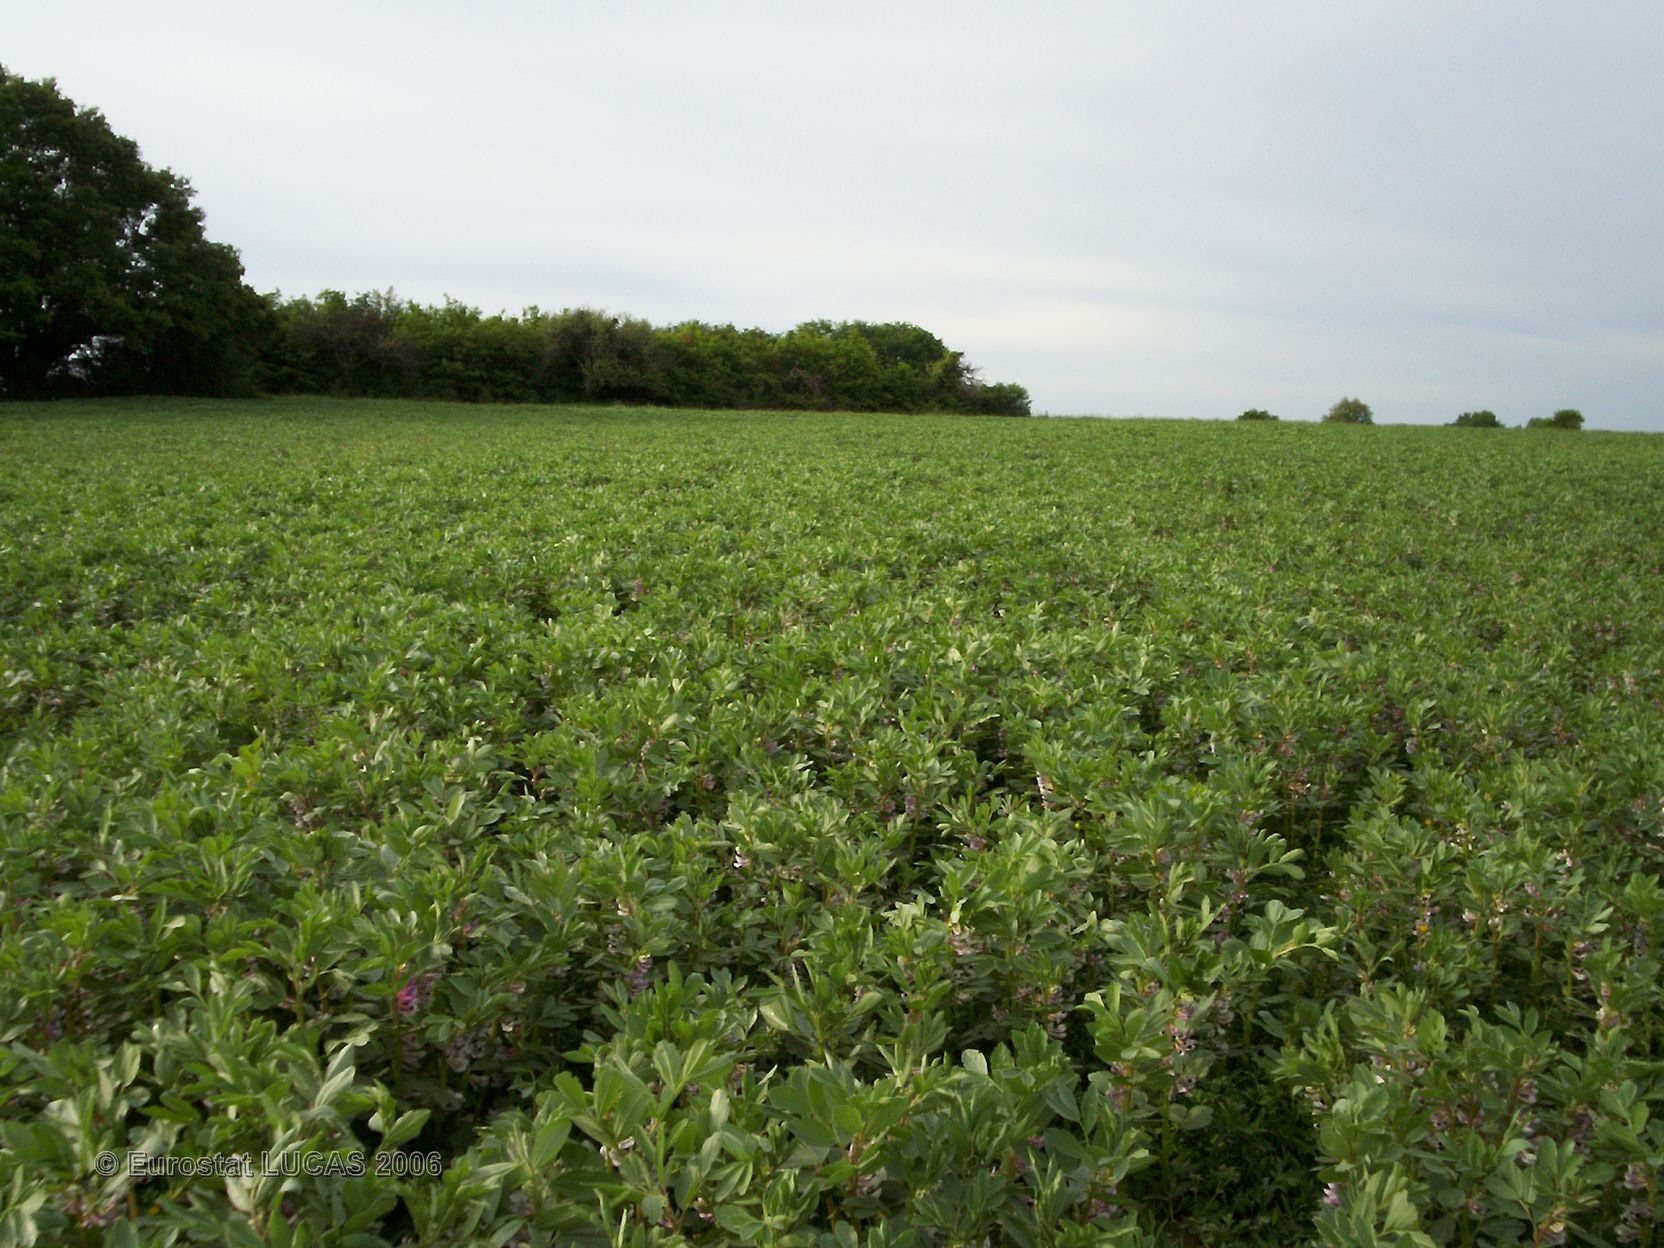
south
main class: Cropland
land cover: Dry pulses
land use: Agriculture (excluding fallow land and kitchen gardens)
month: May
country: FR
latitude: 47.0653
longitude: 1.3092
